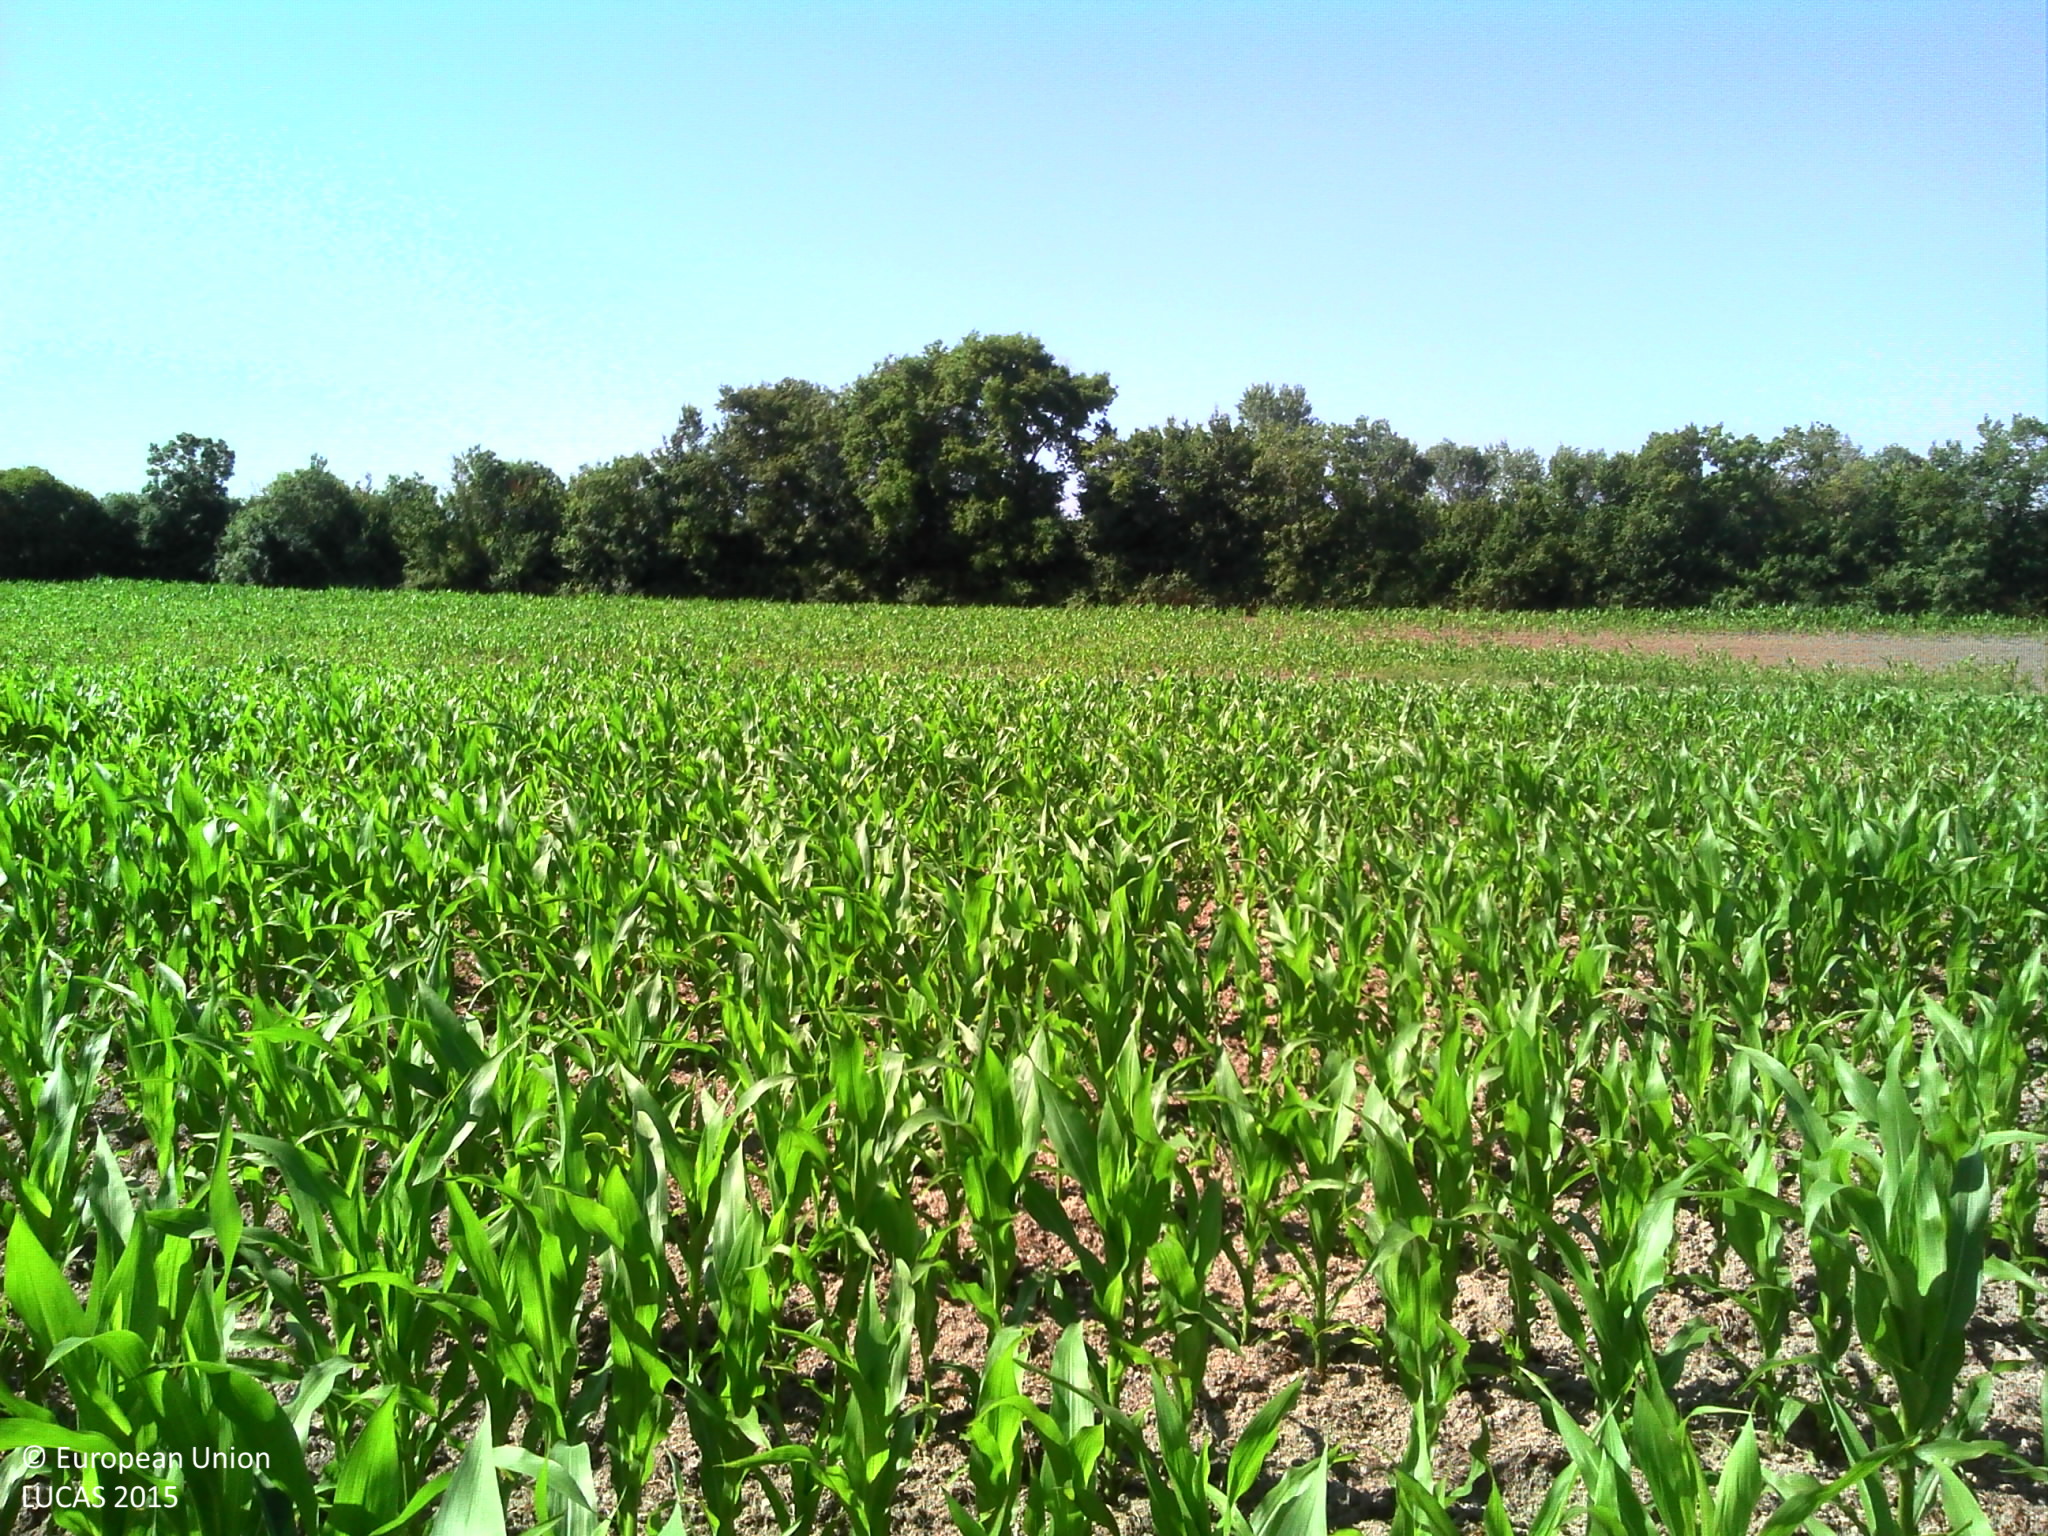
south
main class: Cropland
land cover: Maize
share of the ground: > 75 %
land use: Agriculture (excluding fallow land and kitchen gardens)
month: June
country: FR
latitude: 46.9412
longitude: -1.7215
